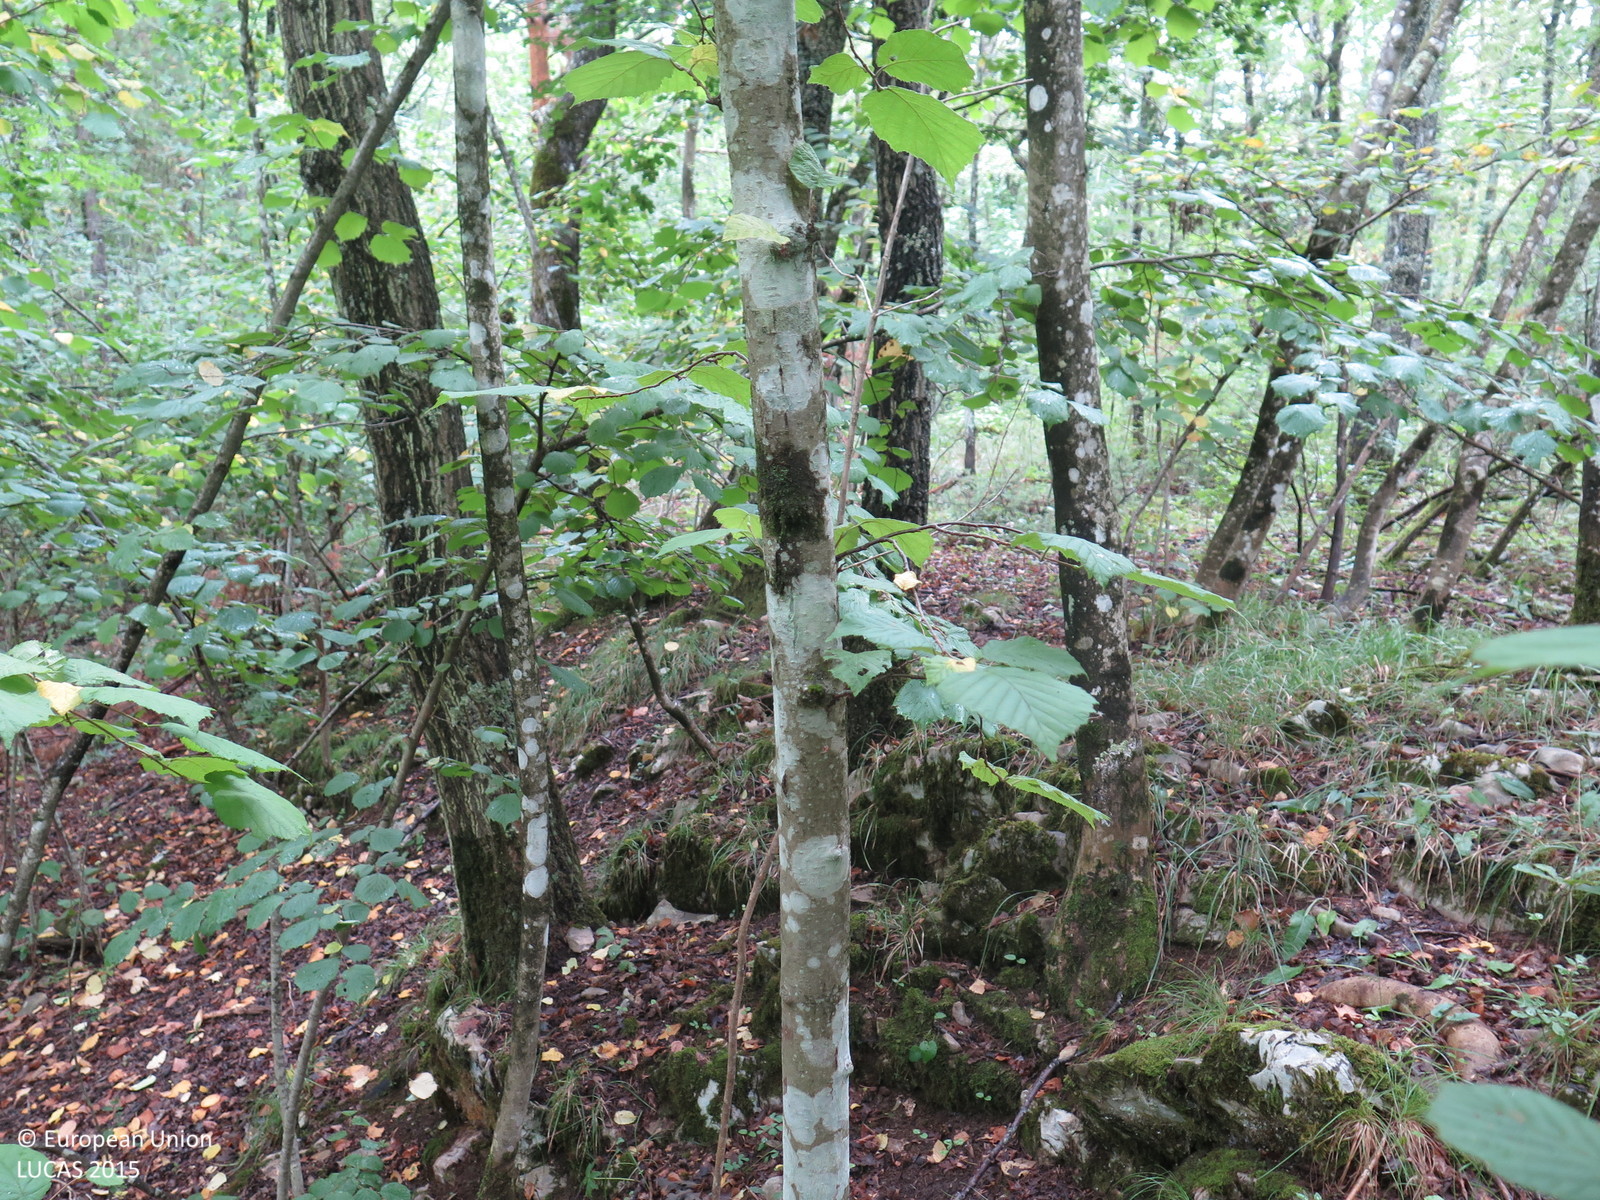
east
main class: Woodland
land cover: Broadleaved woodland
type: beech forest
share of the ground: > 75 %
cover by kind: broadleaved forest trees 95 %, herbaceous plants 5 %
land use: Semi-natural and natural areas not in use
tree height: > 5 m
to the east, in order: Broadleaved woodland; Dry stone walls; Broadleaved woodland
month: August
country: HR
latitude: 45.4898
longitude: 14.2817
